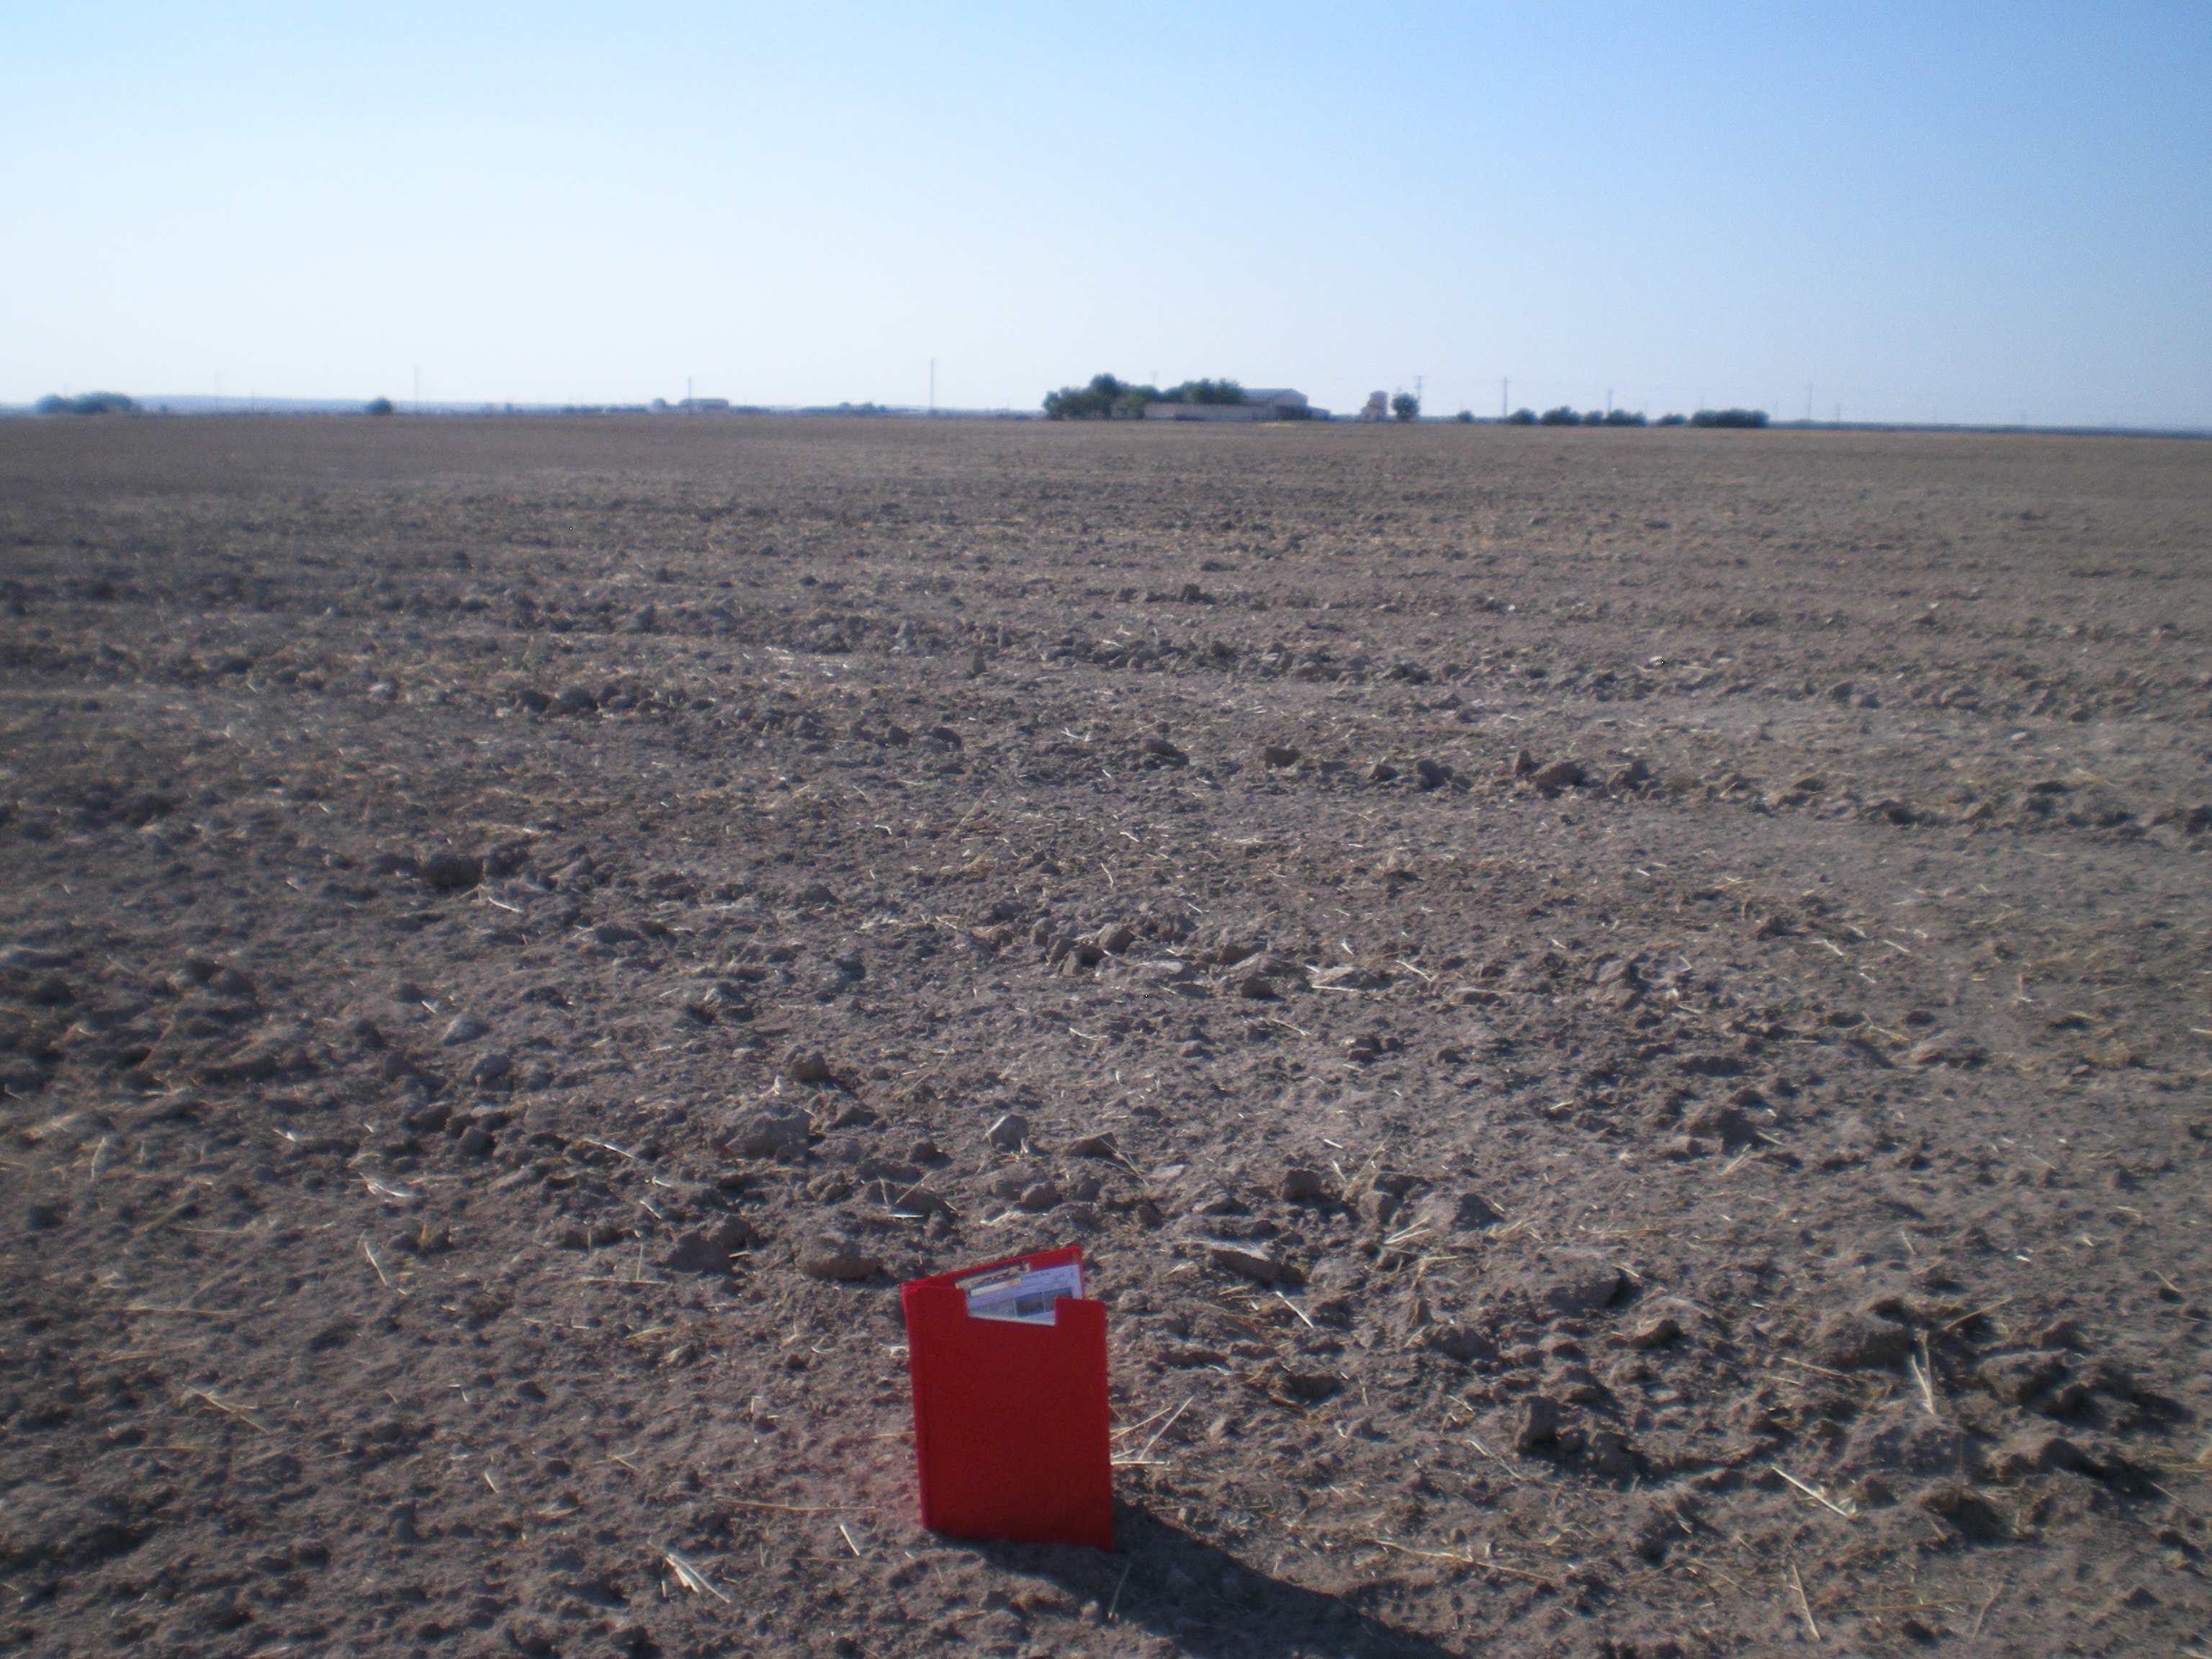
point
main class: Cropland
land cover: Durum wheat
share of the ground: < 10 %
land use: Agriculture (excluding fallow land and kitchen gardens)
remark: Harvested field
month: July
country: ES
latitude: 39.3743
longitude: -3.3100
